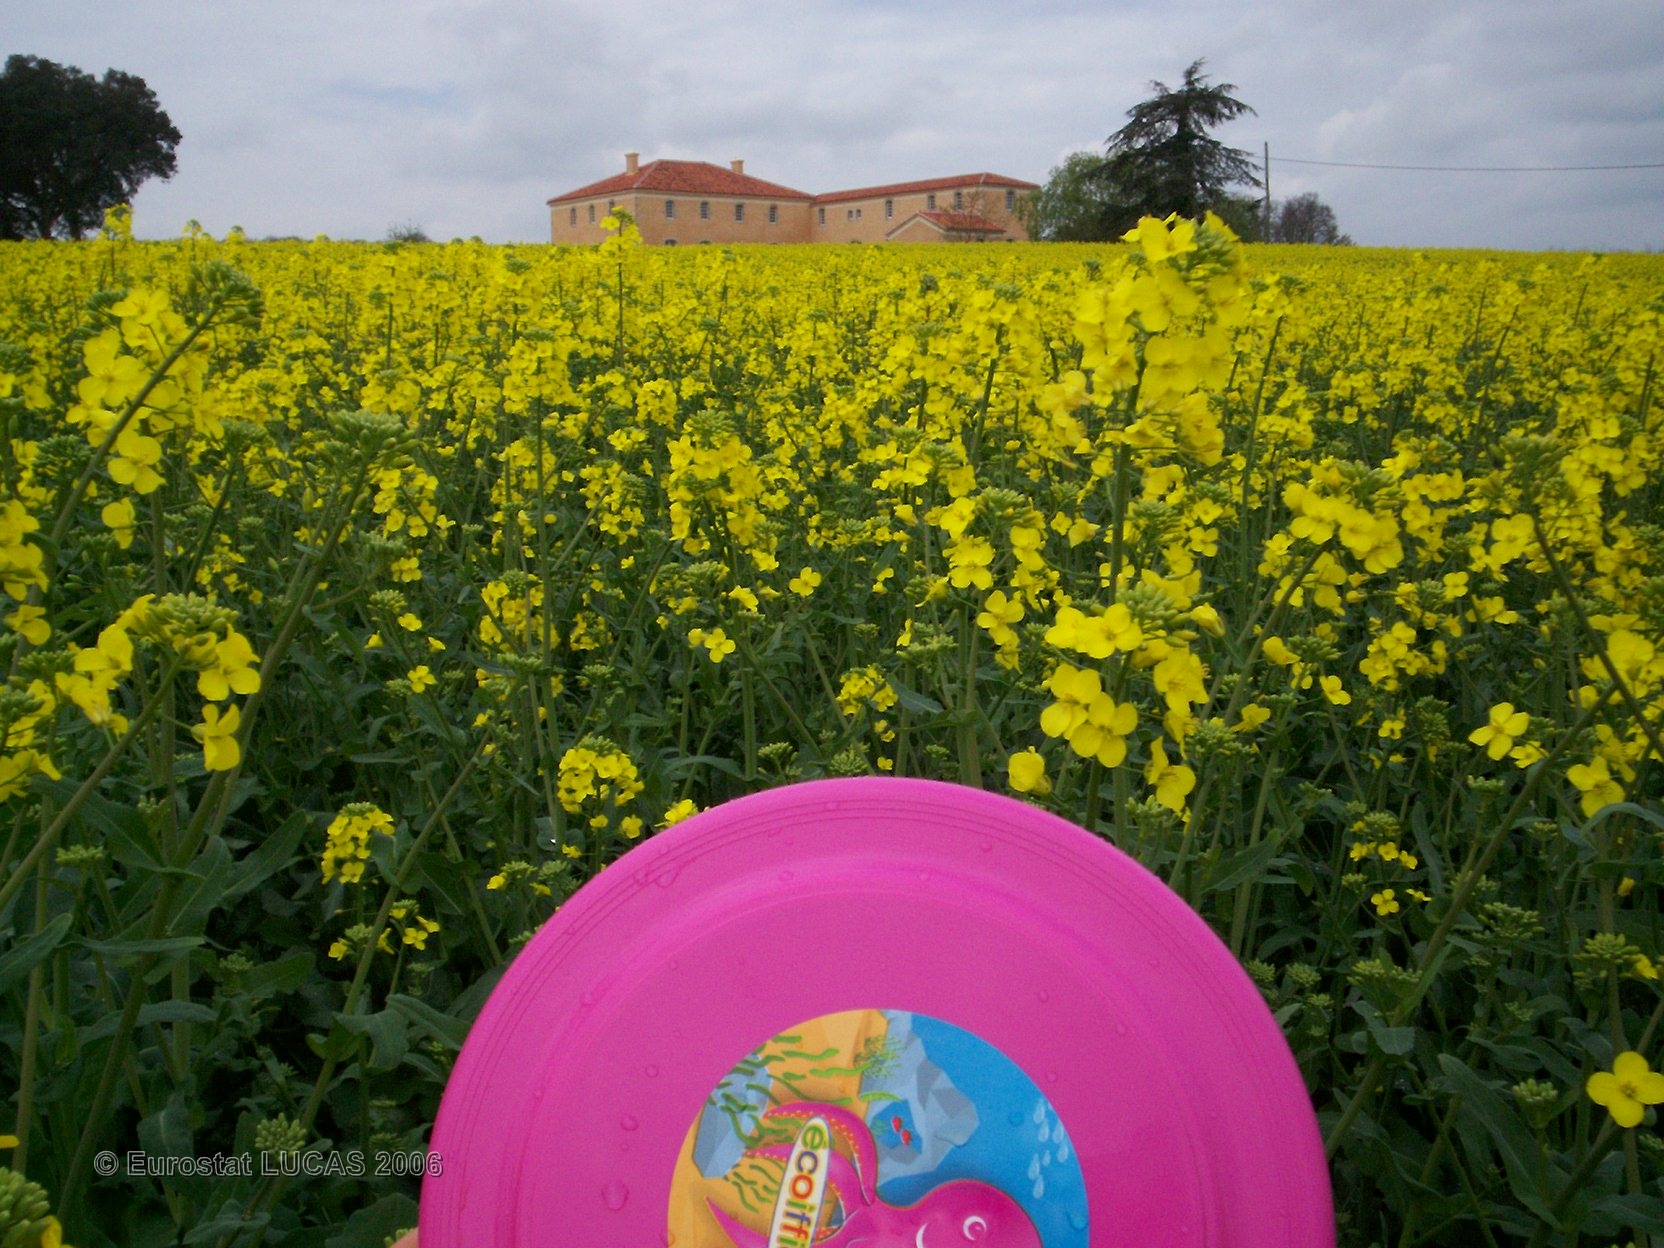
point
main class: Cropland
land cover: Rape and turnip rape
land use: Agriculture (excluding fallow land and kitchen gardens)
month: April
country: FR
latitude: 43.4969
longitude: 0.3136
